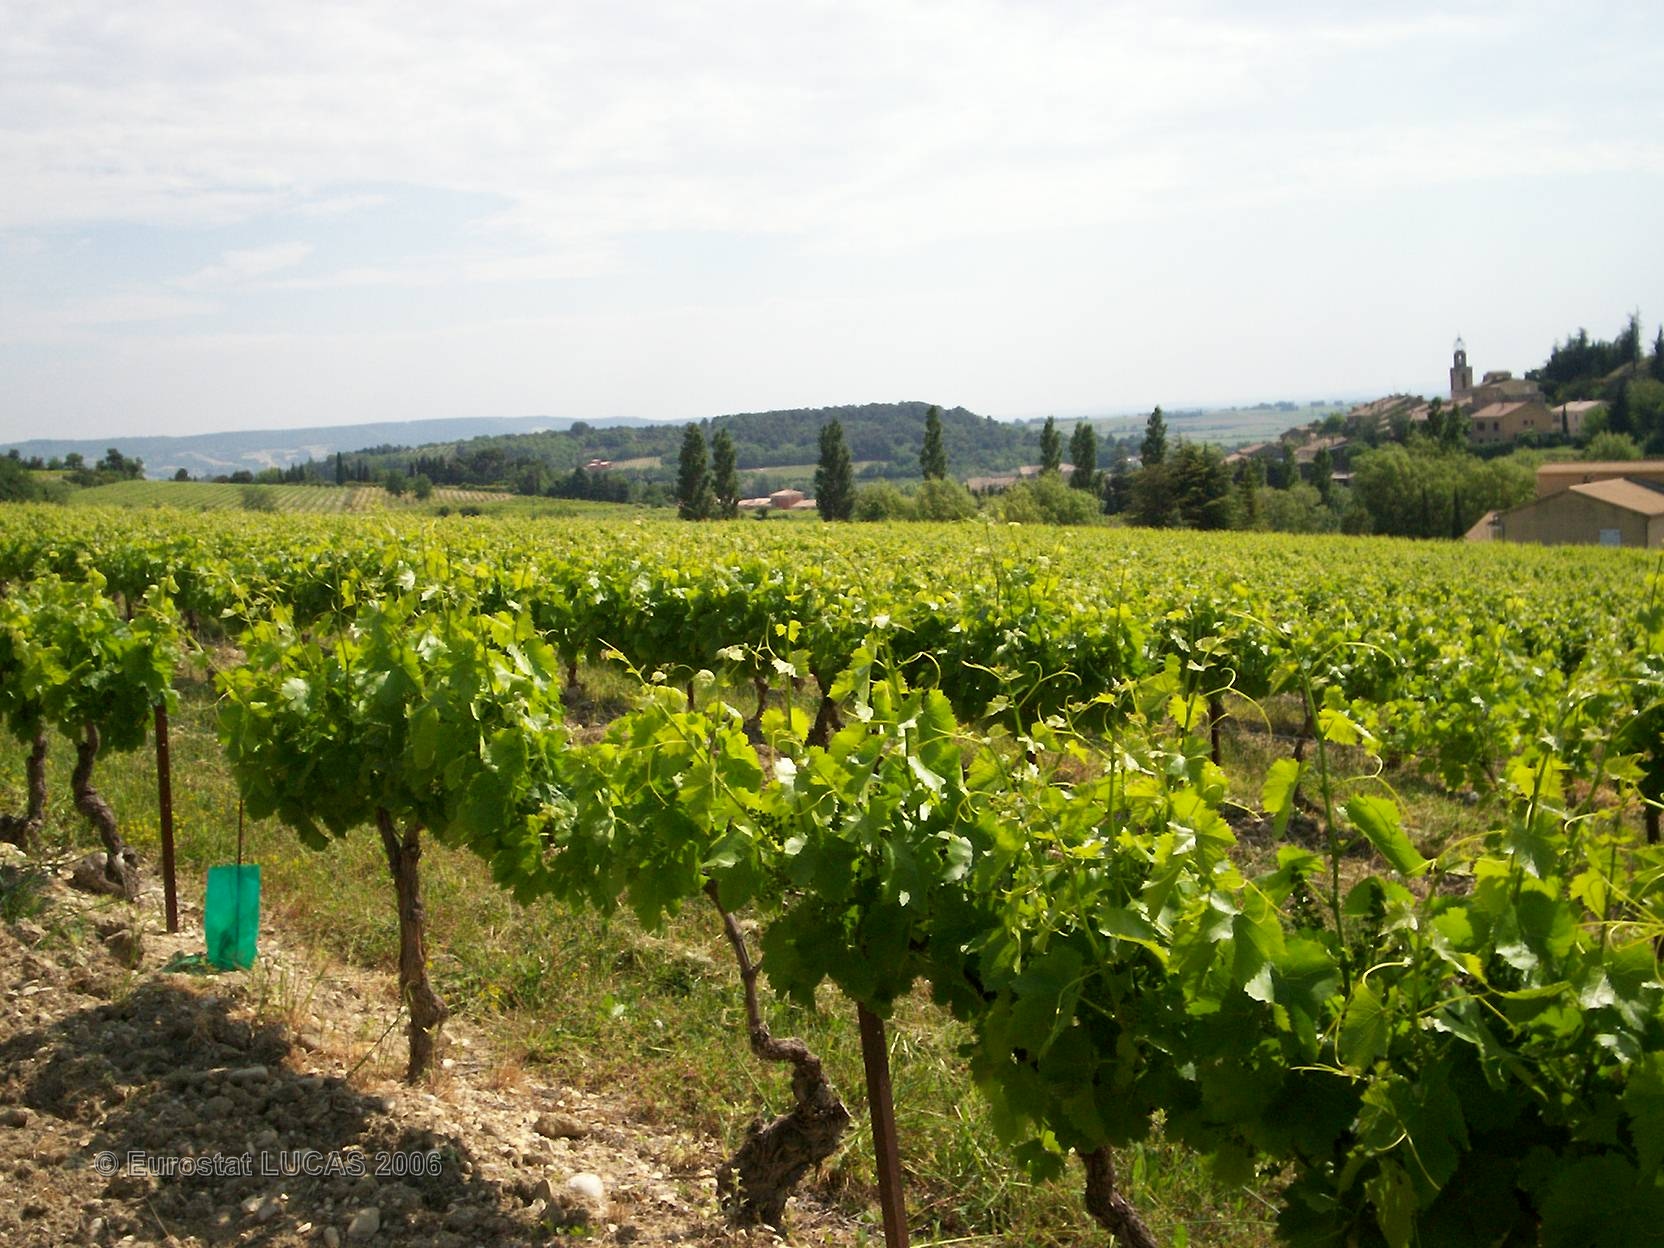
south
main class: Cropland
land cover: Vineyards
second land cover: Grassland with sparse tree/shrub cover
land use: Agriculture (excluding fallow land and kitchen gardens)
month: May
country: FR
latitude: 44.3182
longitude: 4.9546
